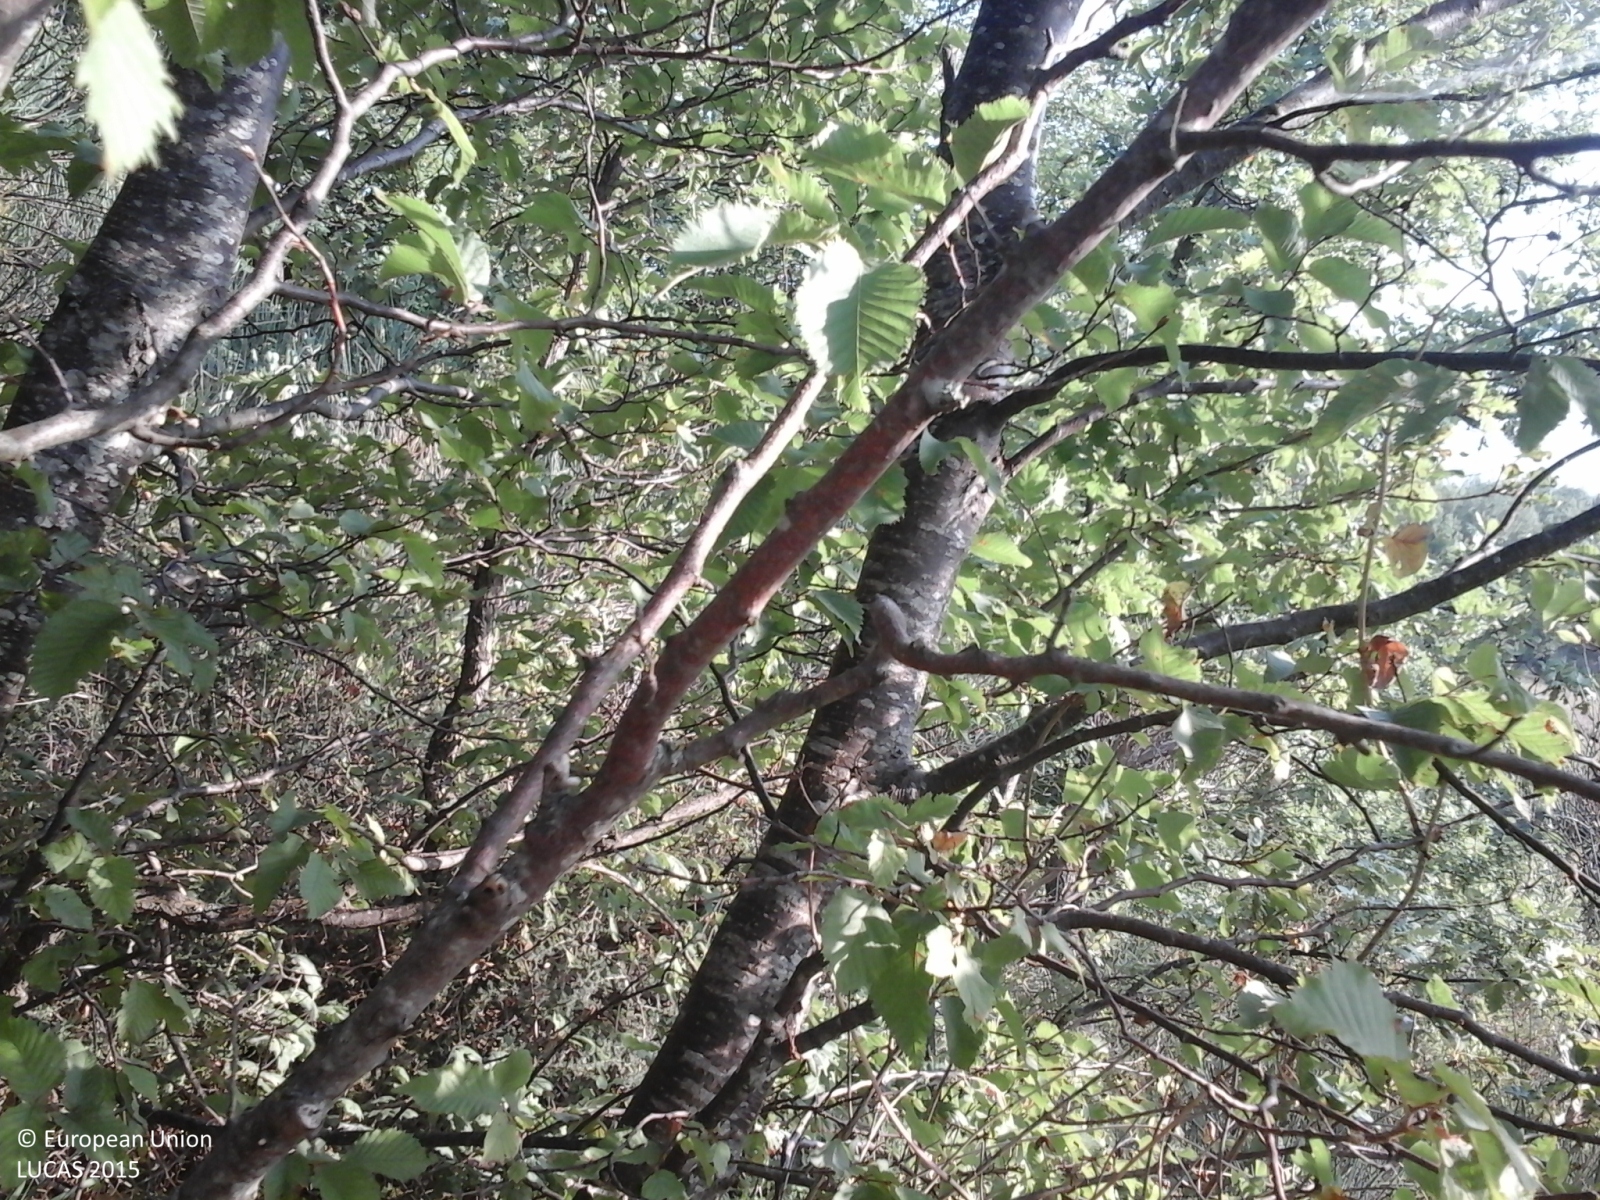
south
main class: Woodland
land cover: Broadleaved woodland
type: thermophilous deciduous forest
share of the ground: > 75 %
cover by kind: broadleaved forest trees 90 %, shrubs 5 %, herbaceous plants 5 %
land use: Forestry
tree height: > 5 m
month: August
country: IT
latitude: 43.4003
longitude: 13.1405
